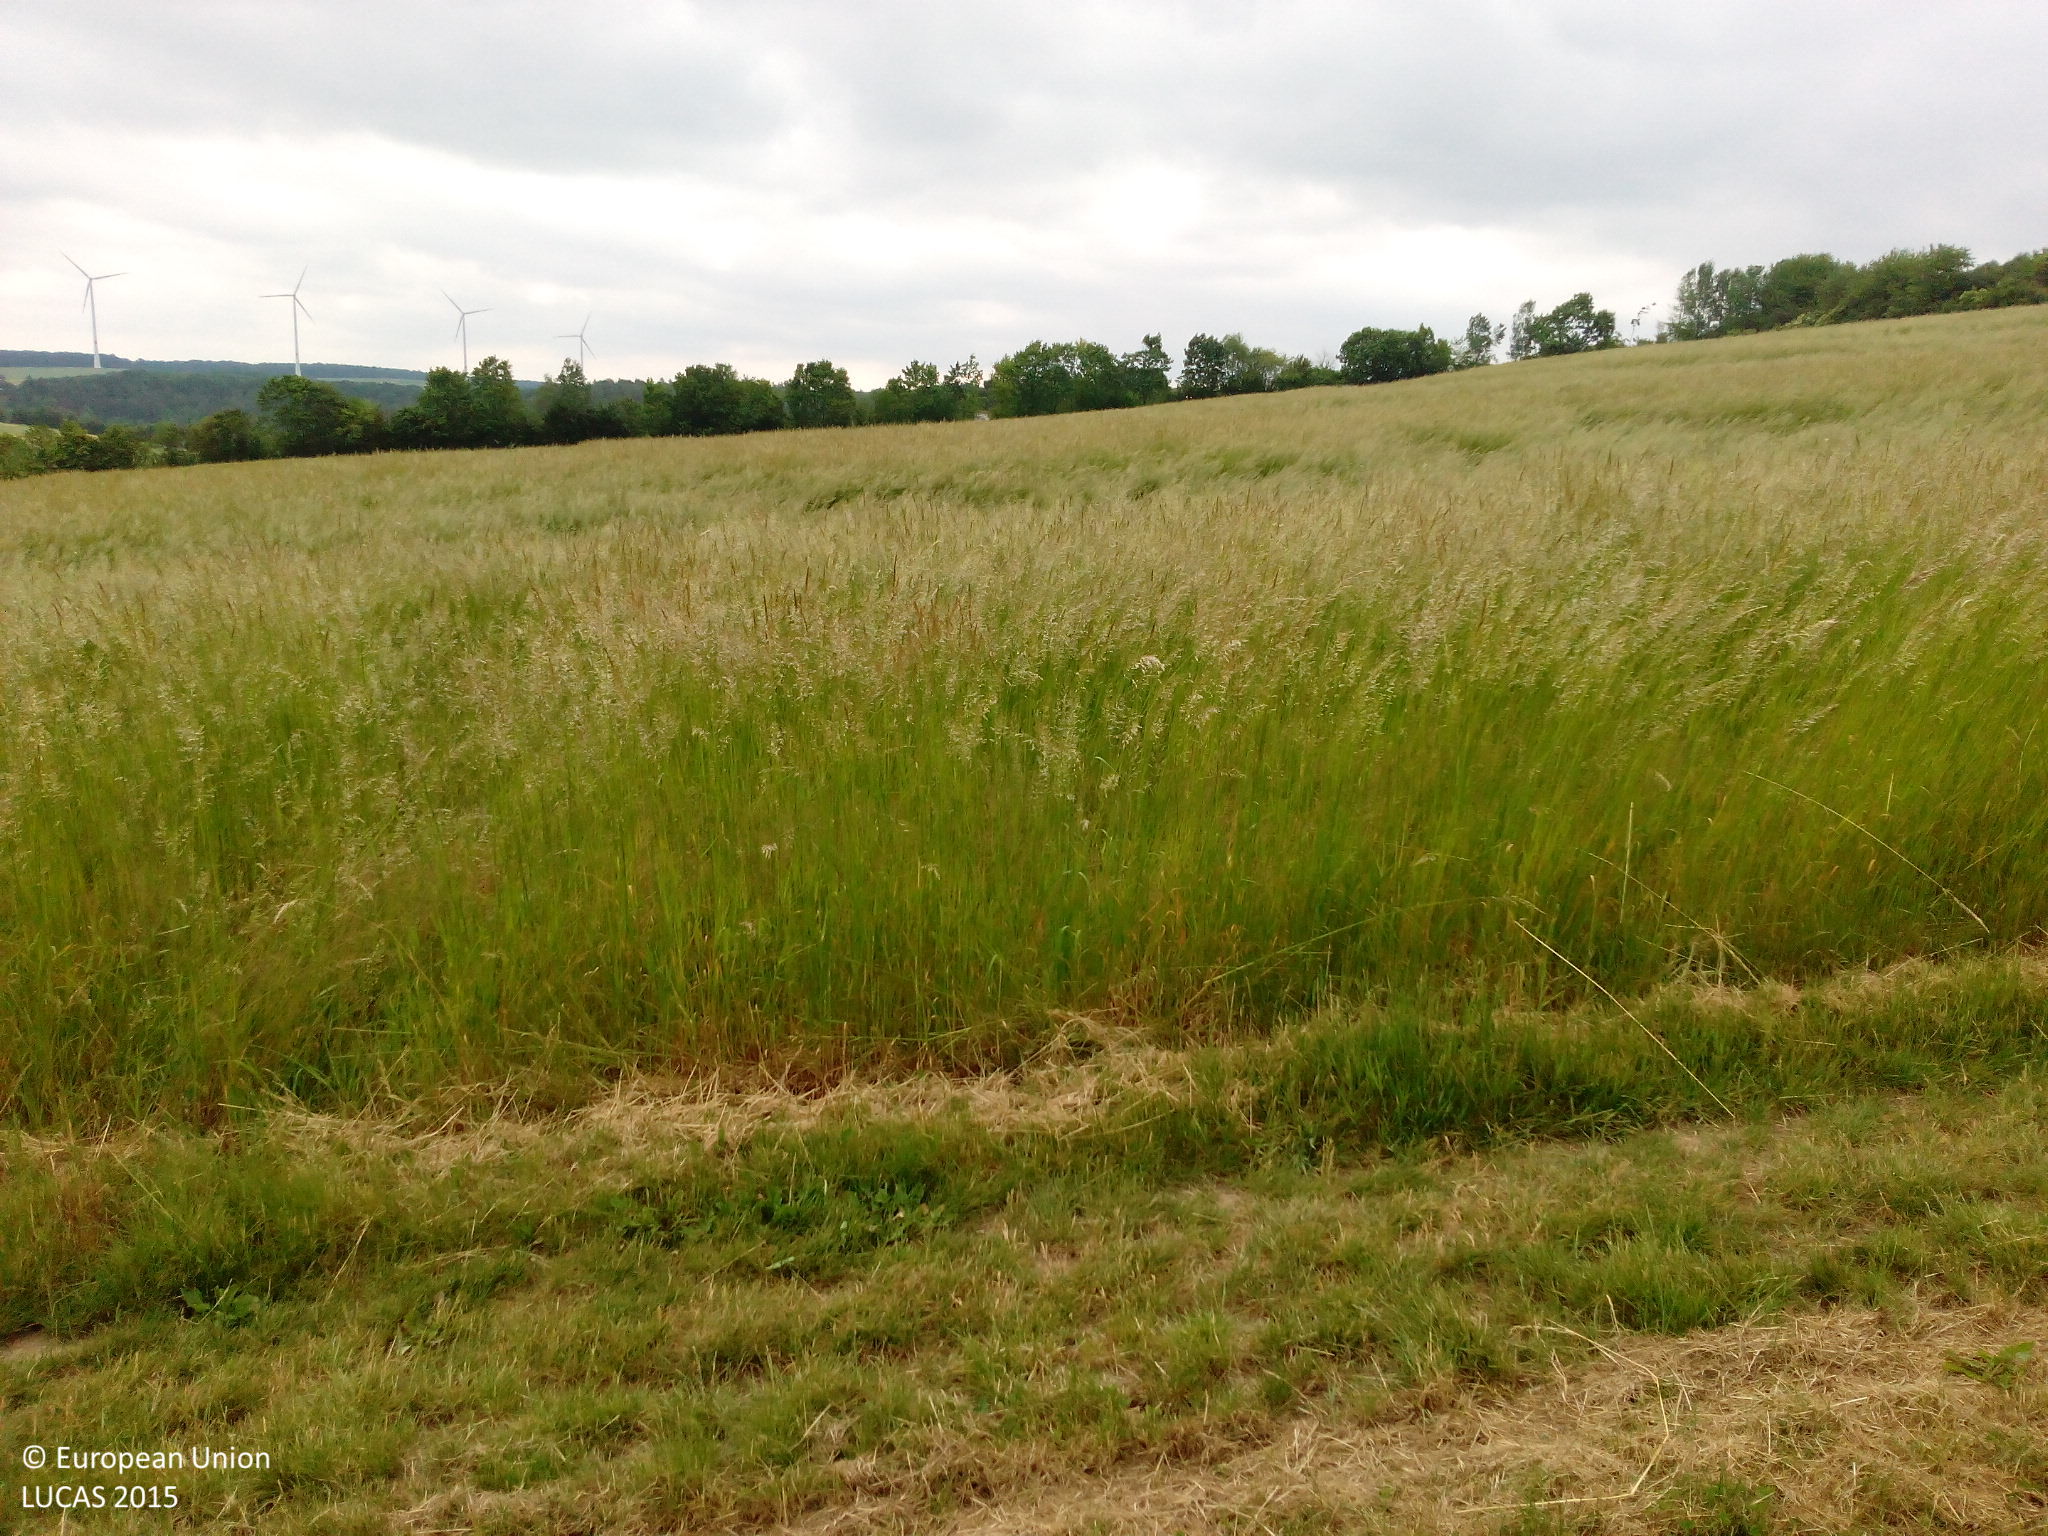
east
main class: Cropland
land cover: Common wheat
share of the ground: > 75 %
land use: Agriculture (excluding fallow land and kitchen gardens)
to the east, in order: Common wheat; Grass margins; Tracks; Temporary grasslands; Tracks; Abandoned hedges; Grass margins; Tracks; Barley
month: June
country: DE
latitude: 50.1659
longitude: 10.2659
